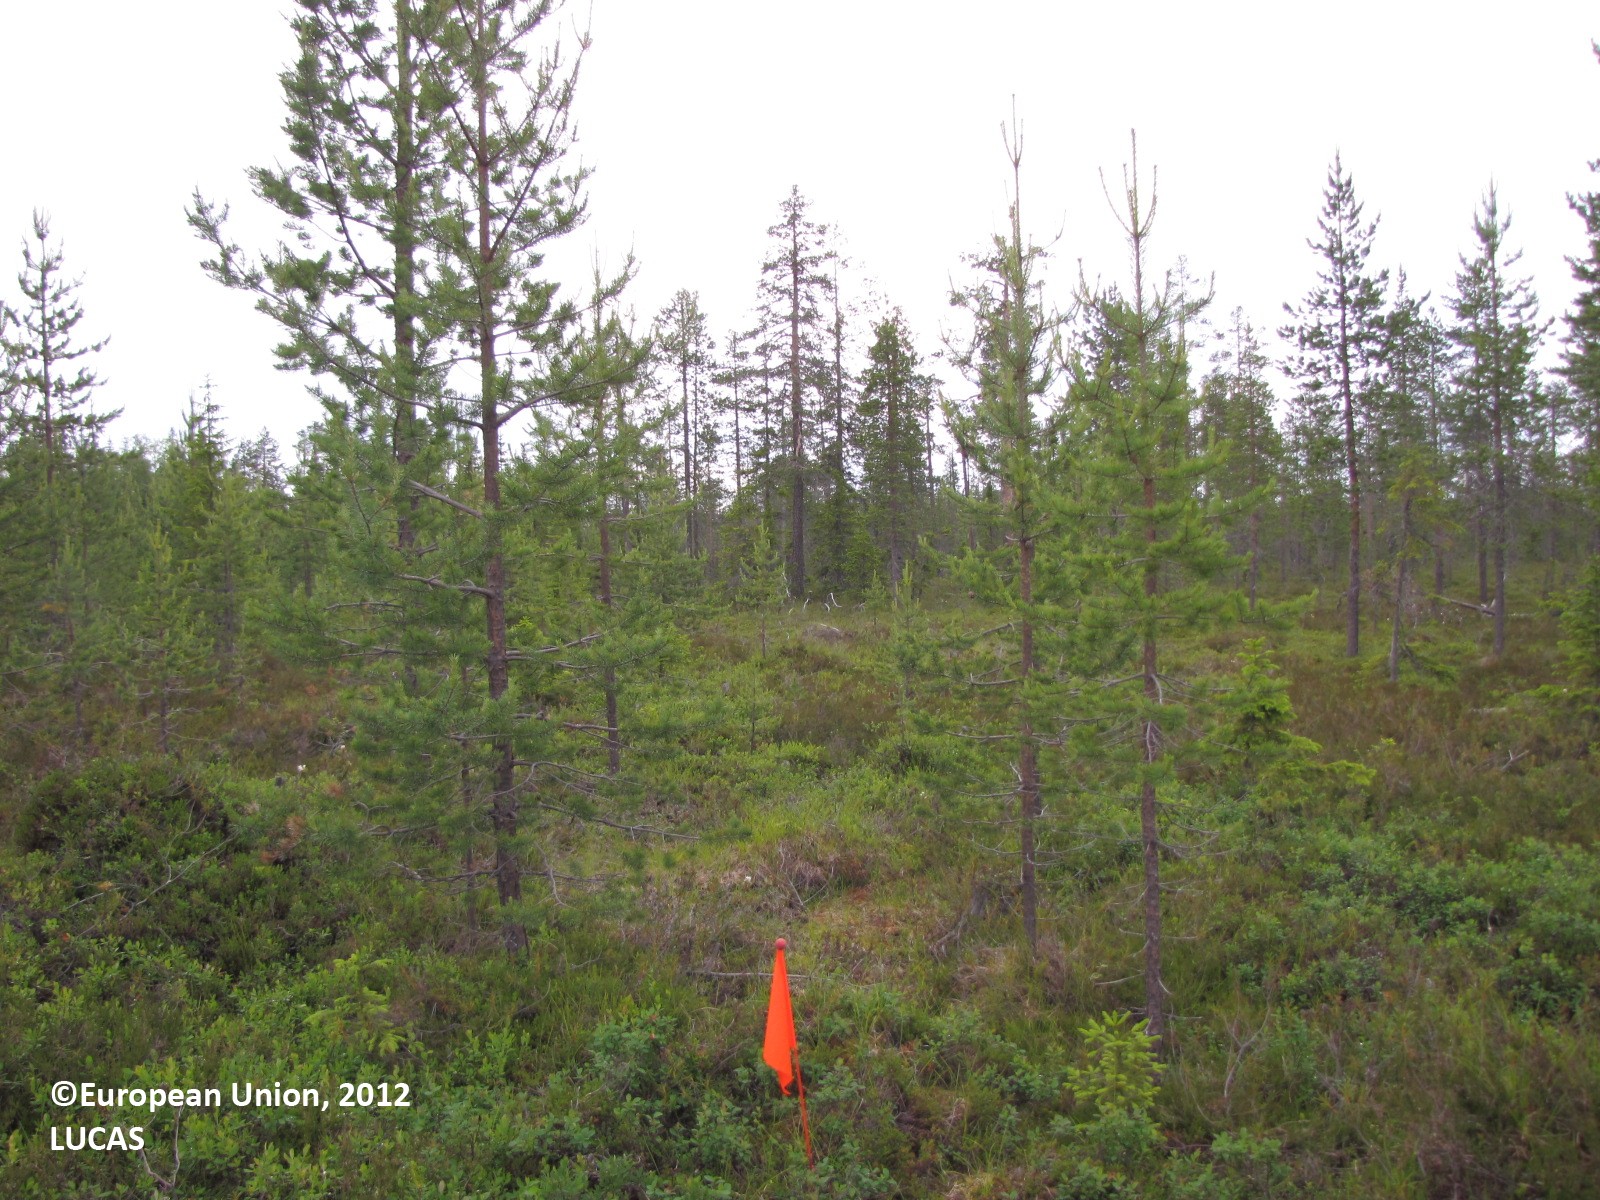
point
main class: Woodland
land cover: Pine dominated coniferous woodland
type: boreal forest
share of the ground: 10 - 25 %
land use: Forestry
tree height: > 5 m
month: July
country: FI
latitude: 66.5481
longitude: 25.1656
